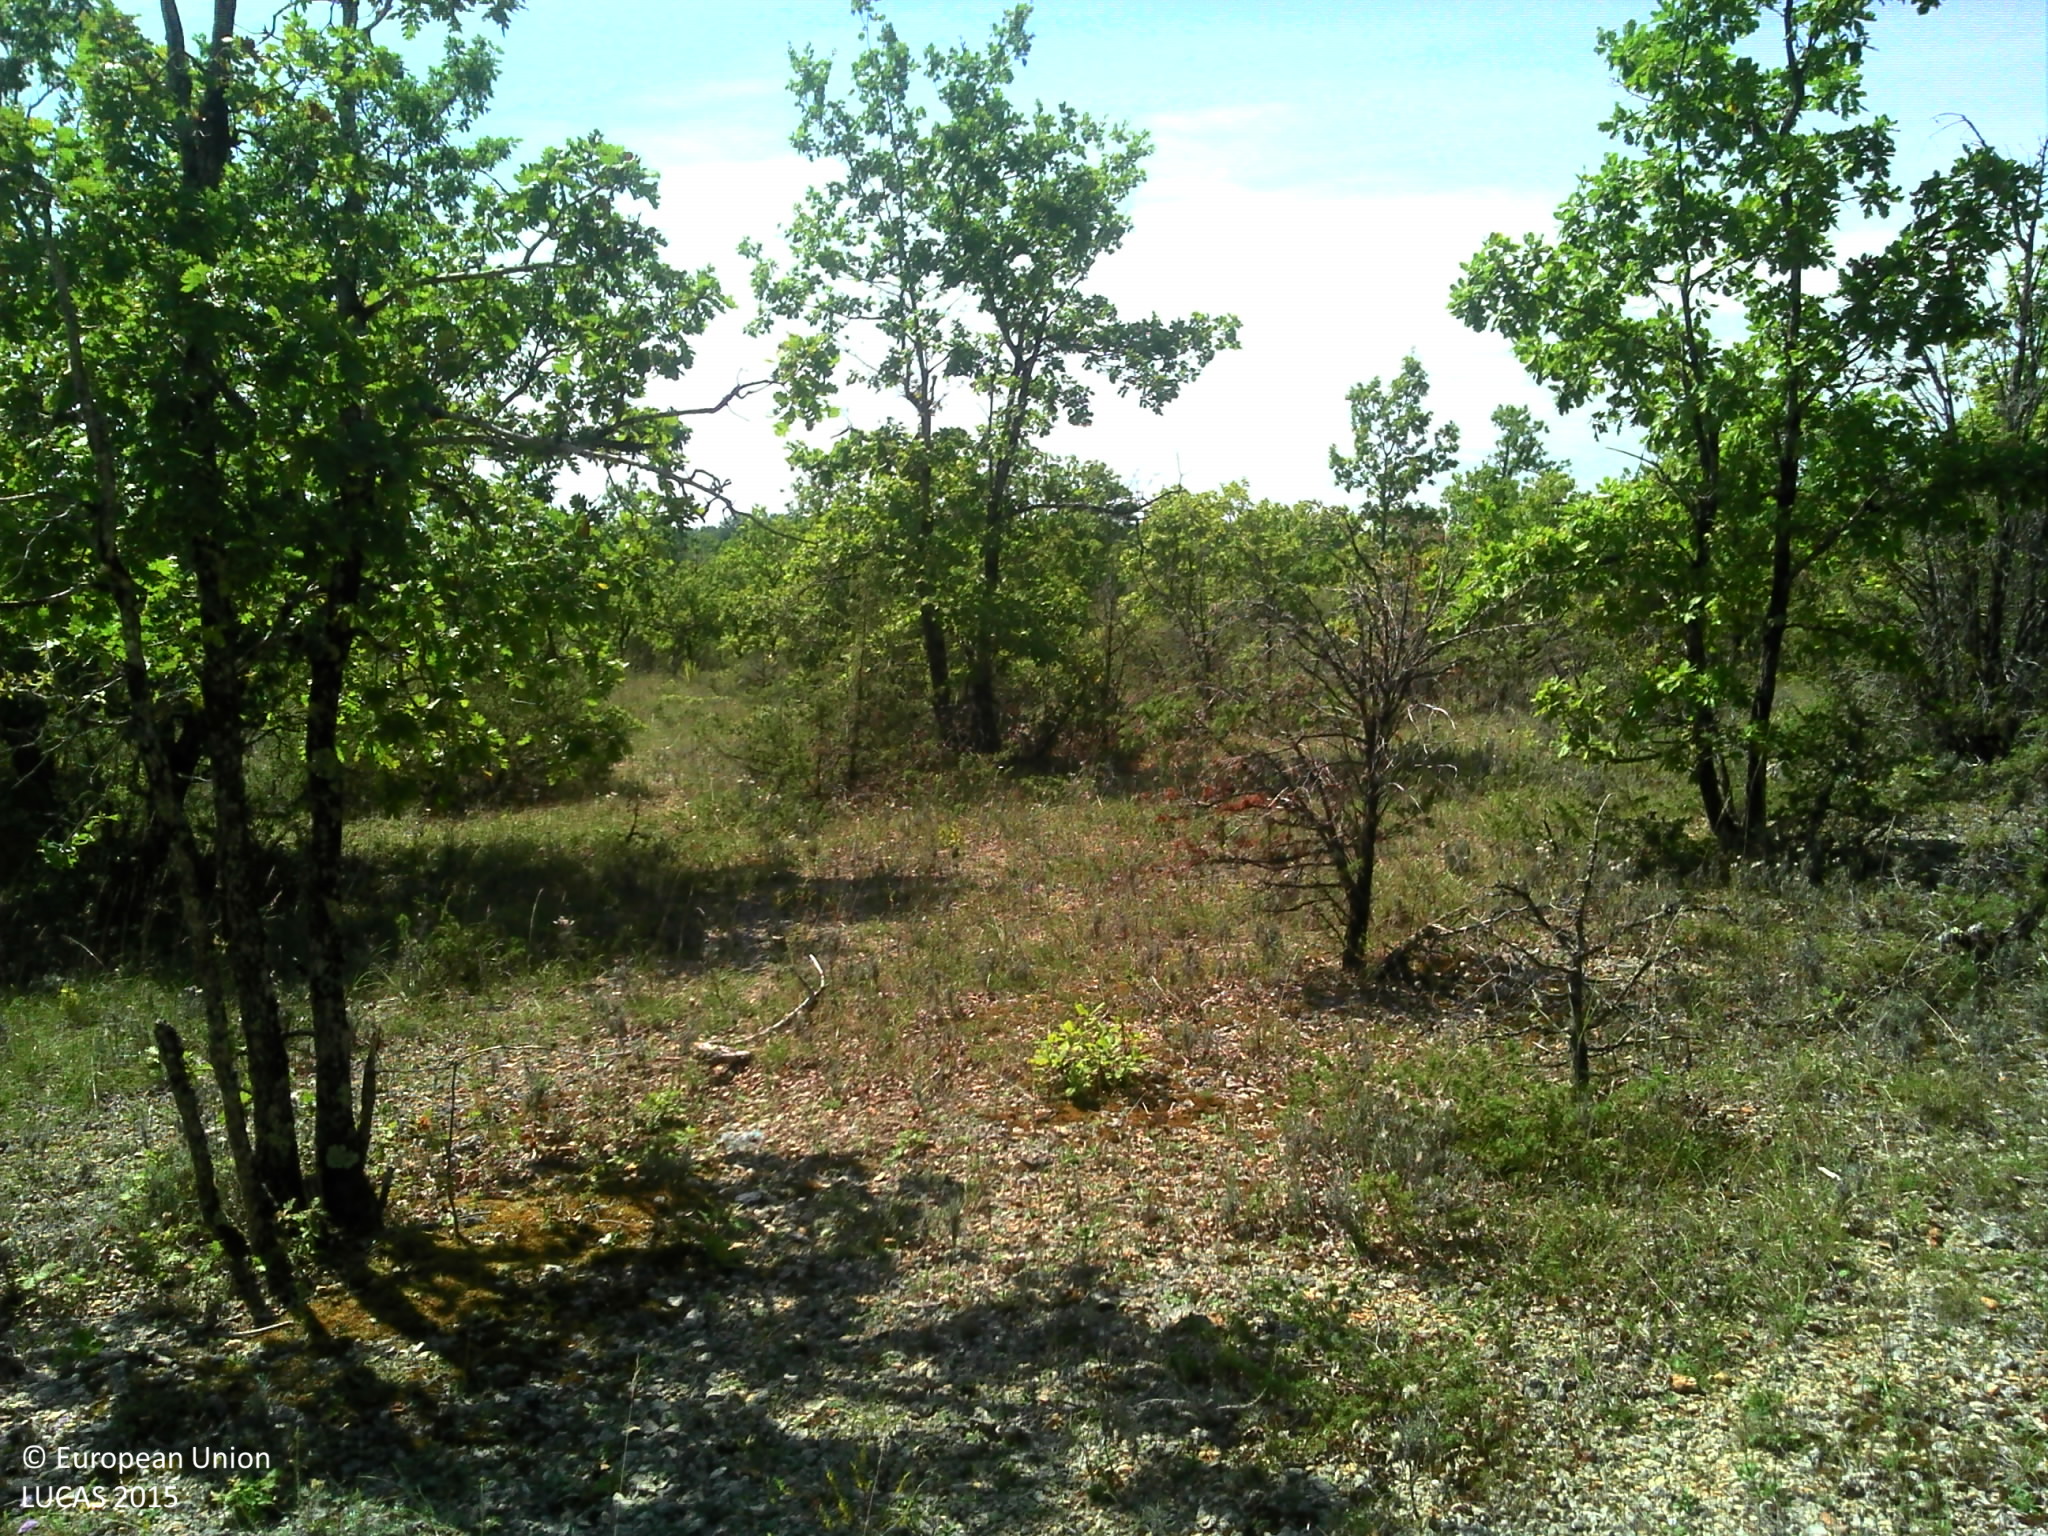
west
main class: Woodland
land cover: Broadleaved woodland
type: thermophilous deciduous forest
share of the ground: > 75 %
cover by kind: broadleaved forest trees 50 %, herbaceous plants 20 %, shrubs 15 %, consolidated bare surface 15 %
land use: Forestry
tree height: > 5 m
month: August
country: FR
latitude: 44.3971
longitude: 1.2466
